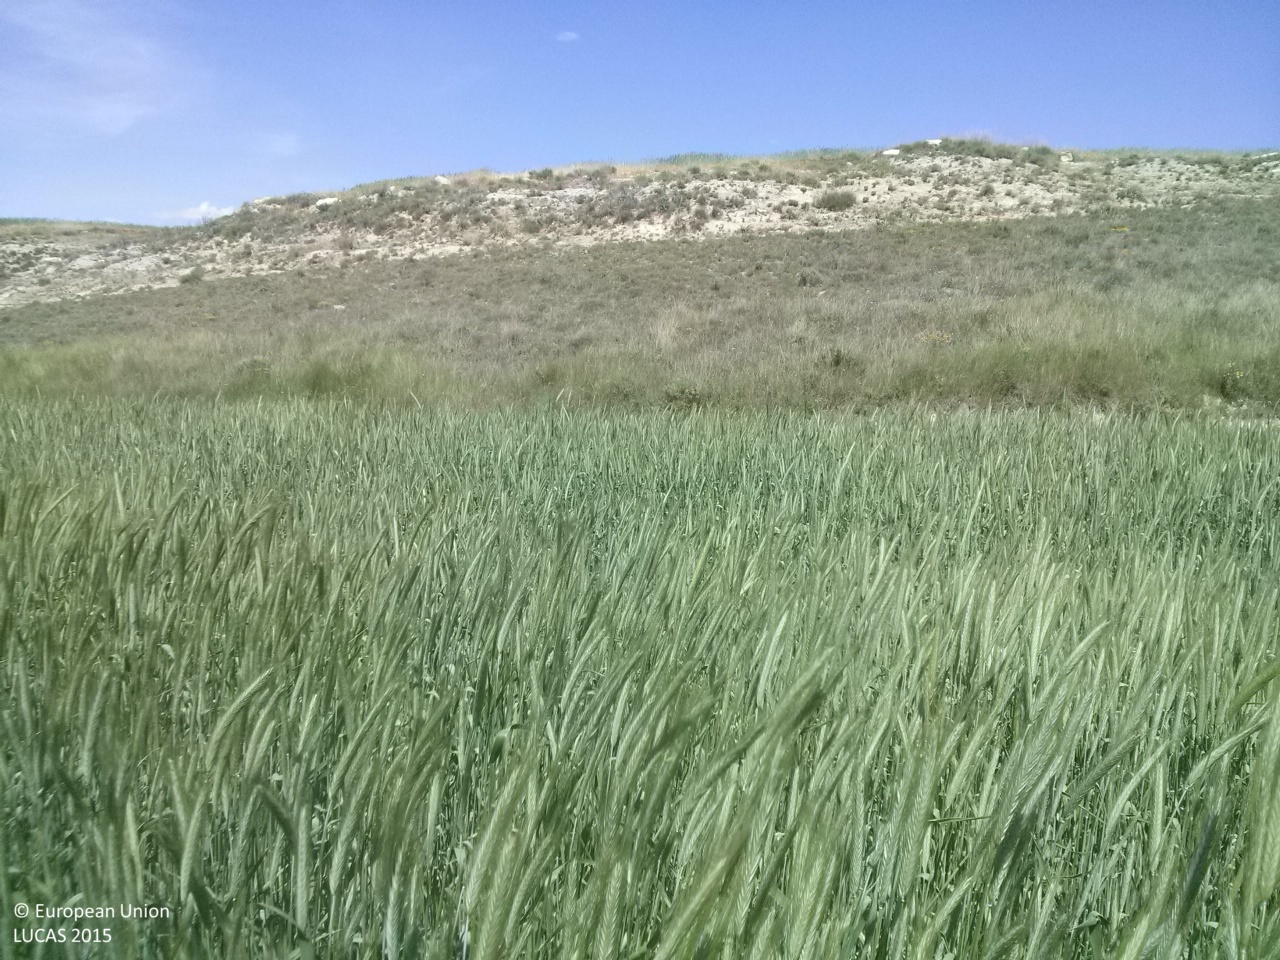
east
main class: Cropland
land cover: Rye
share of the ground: > 75 %
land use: Agriculture (excluding fallow land and kitchen gardens)
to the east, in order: Rye; Shrubland without tree cover; Rye; Grass margins; Spontaneously vegetated surfaces
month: May
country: ES
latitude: 40.1471
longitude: -2.7353
